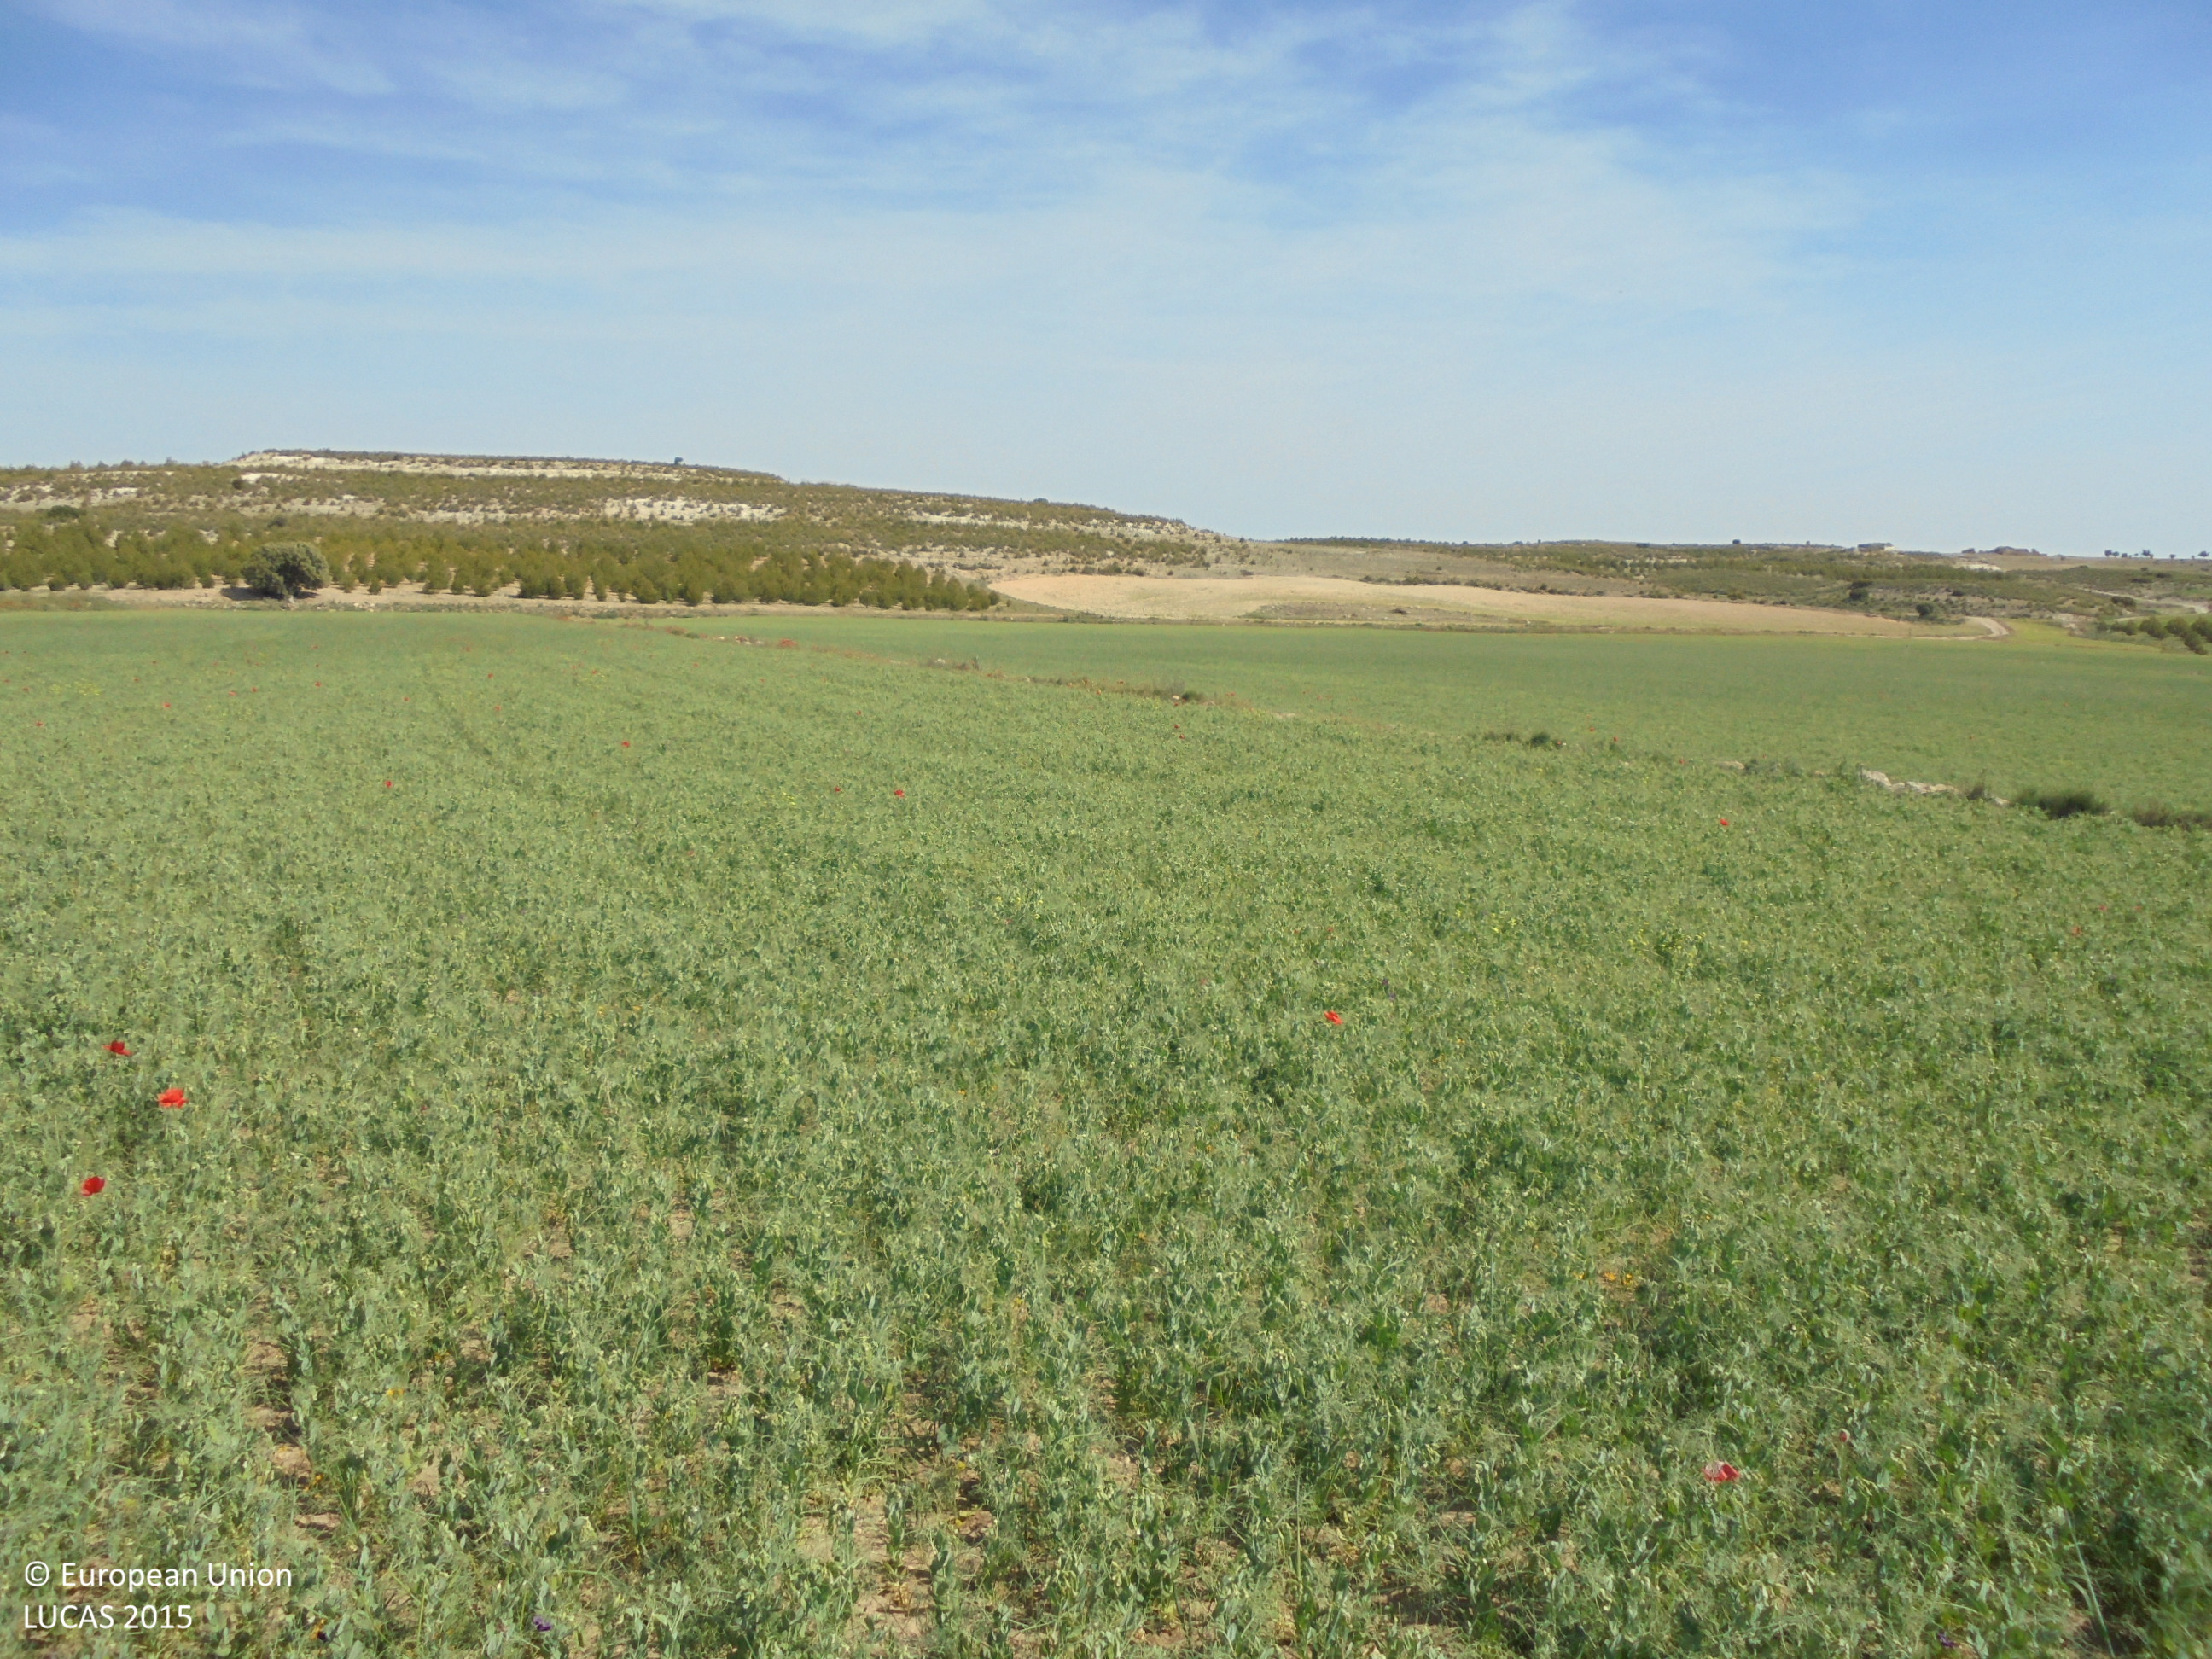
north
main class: Cropland
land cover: Dry pulses
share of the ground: 50 - 75 %
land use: Agriculture (excluding fallow land and kitchen gardens)
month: May
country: ES
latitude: 39.1461
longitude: -1.5359
